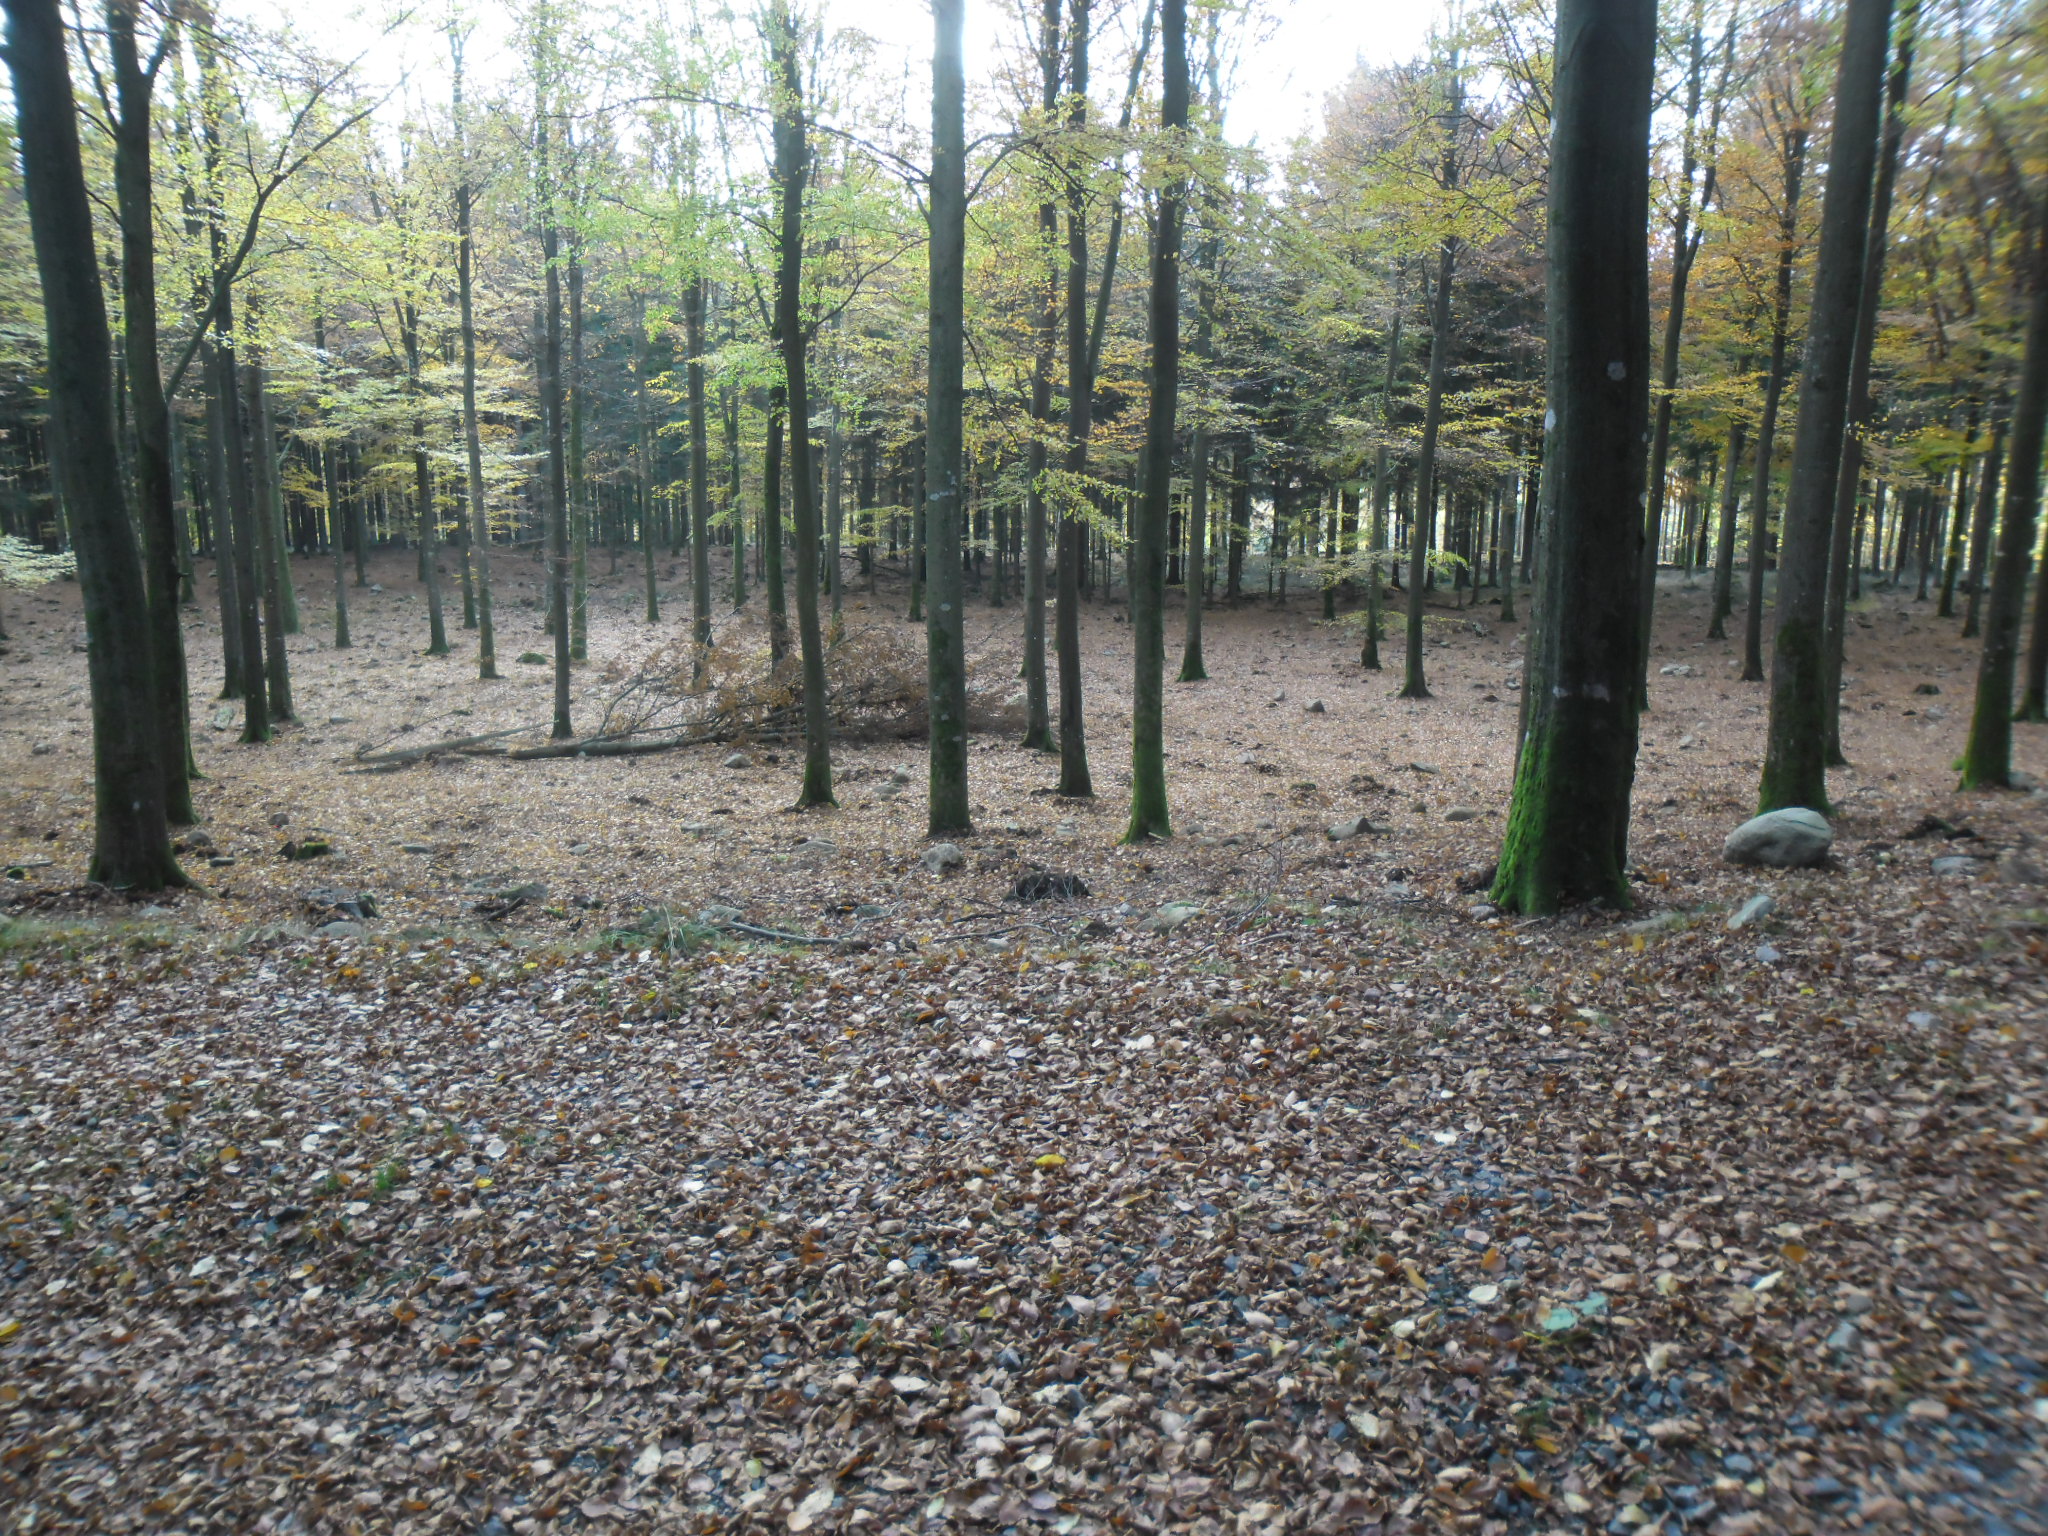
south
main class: Woodland
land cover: Spruce dominated coniferous woodland
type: boreal forest
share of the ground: > 75 %
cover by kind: coniferous forest trees 80 %, lichens and mosses 20 %
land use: Forestry
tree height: > 5 m
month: October
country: SE
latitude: 56.3298
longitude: 13.1186
